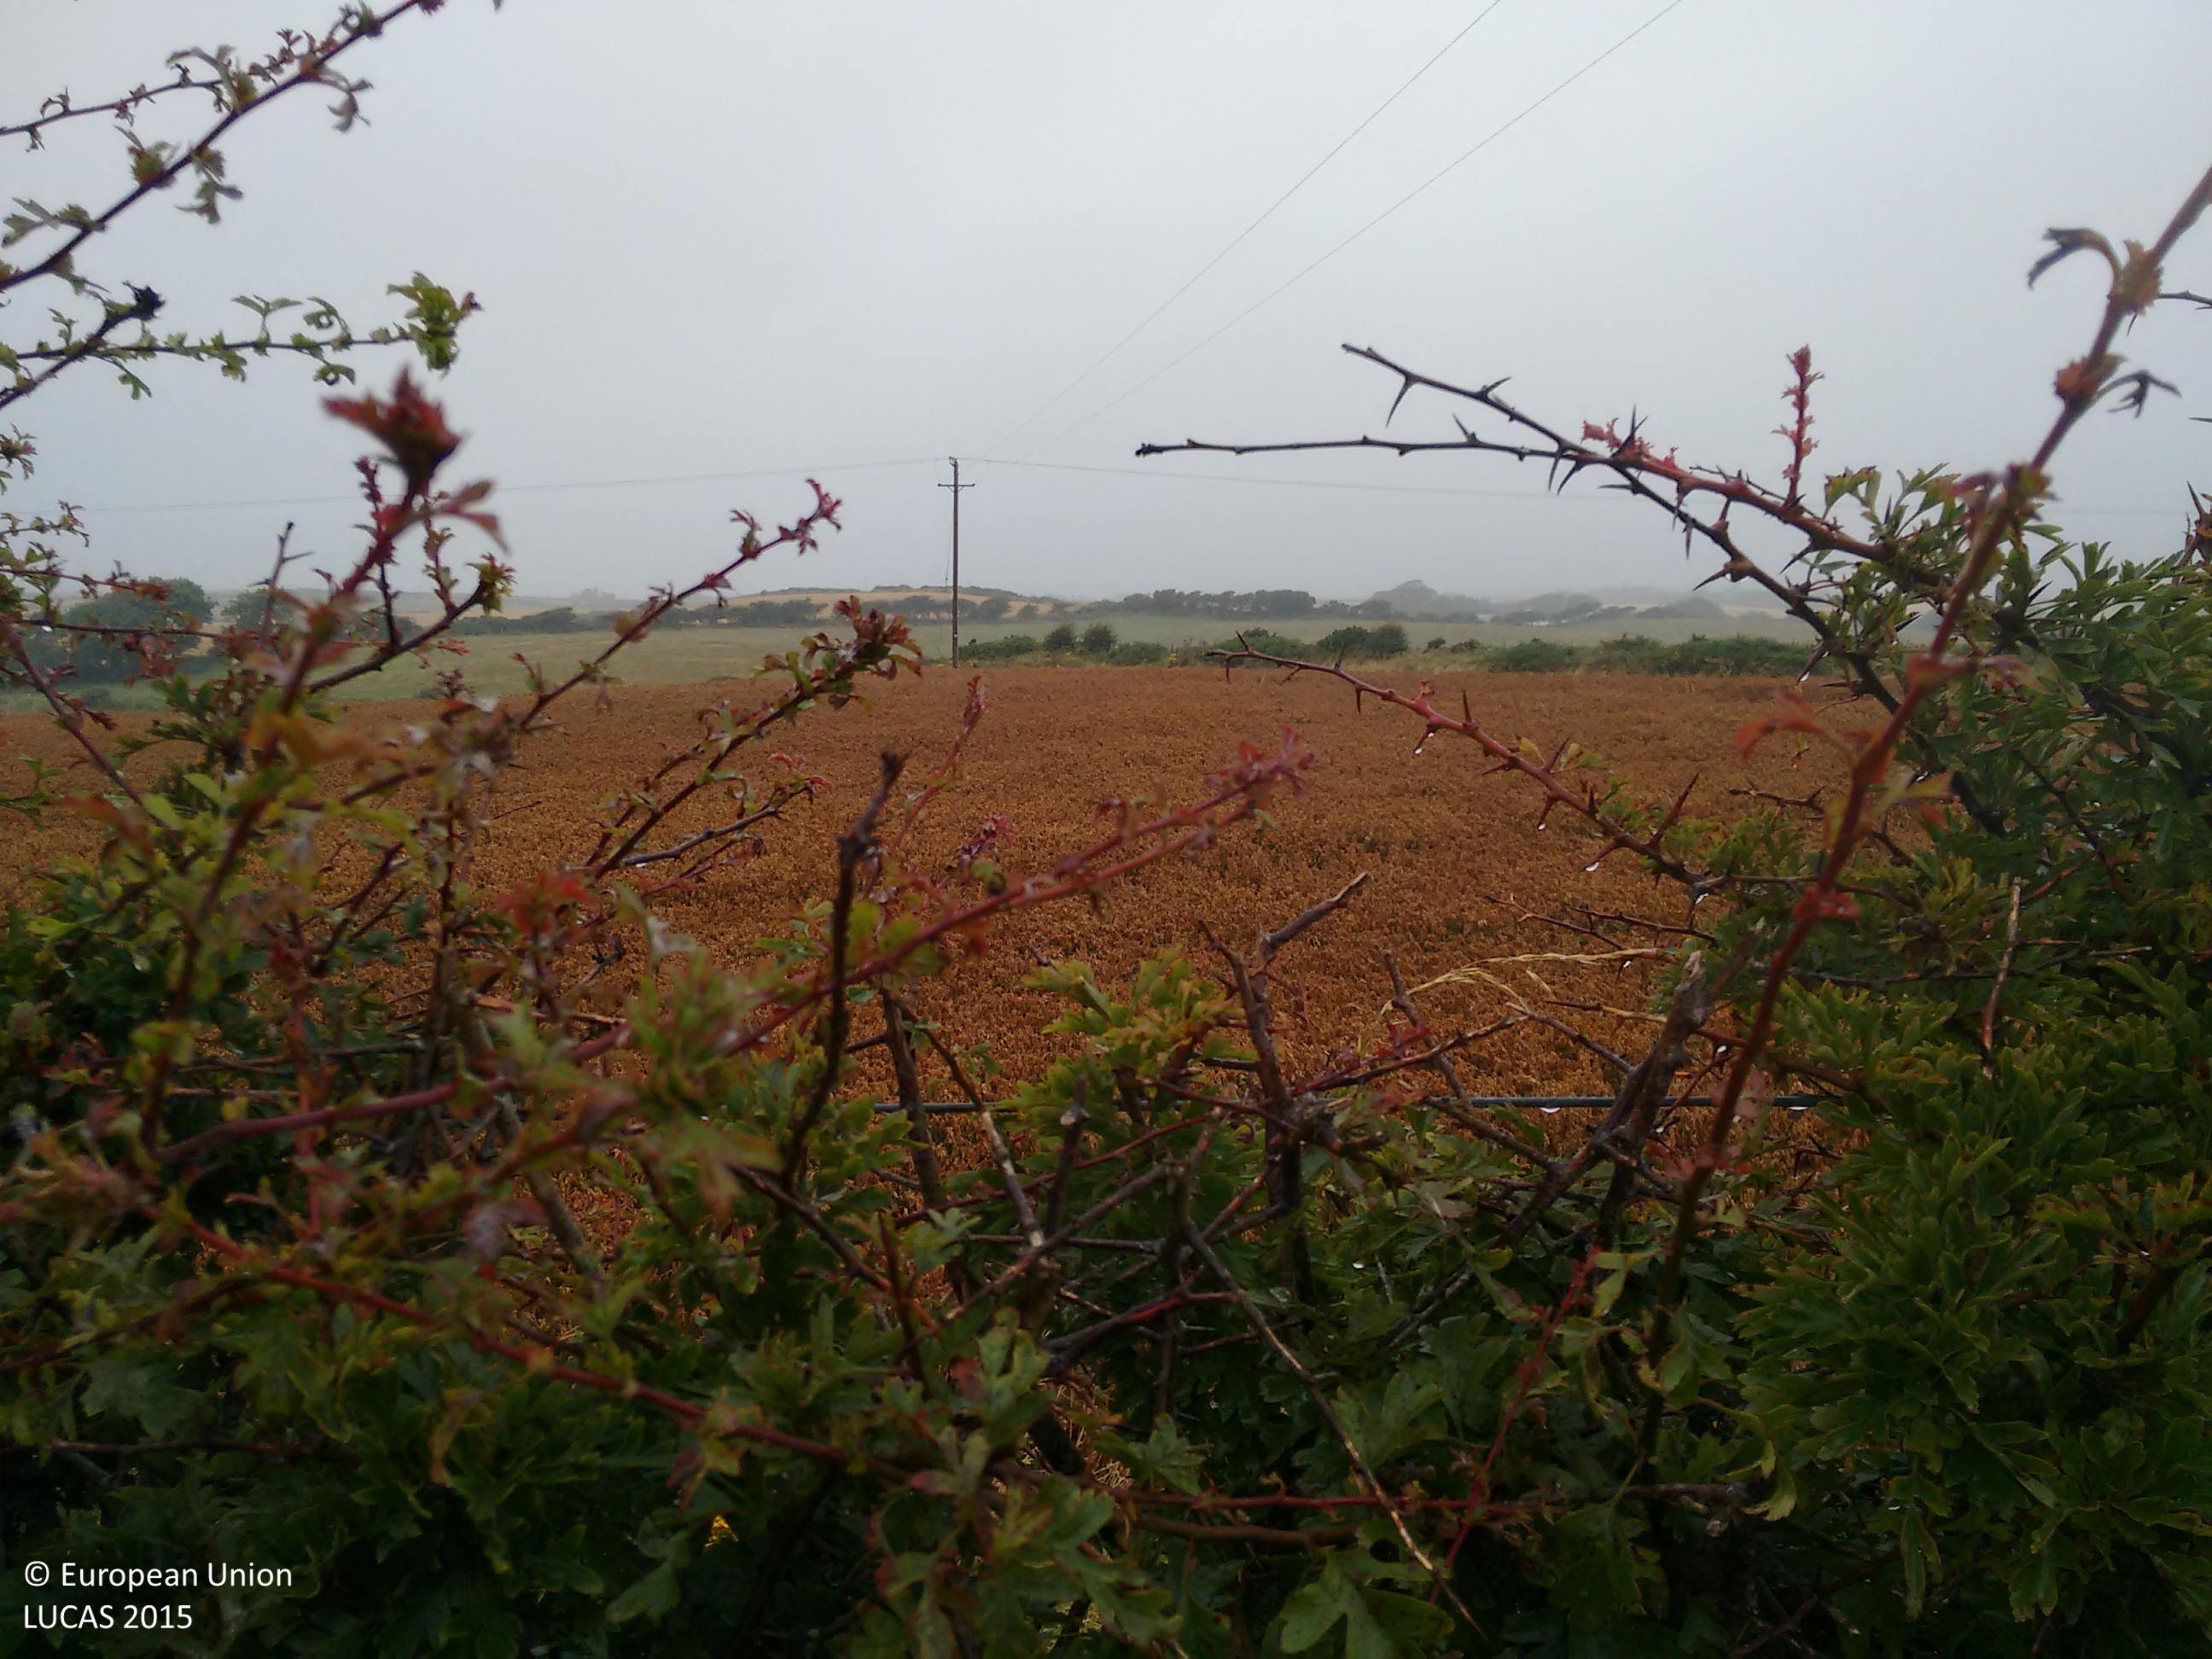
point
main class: Cropland
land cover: Potatoes
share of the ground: > 75 %
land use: Agriculture (excluding fallow land and kitchen gardens)
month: August
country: GB
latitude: 54.3142
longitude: -5.5468
